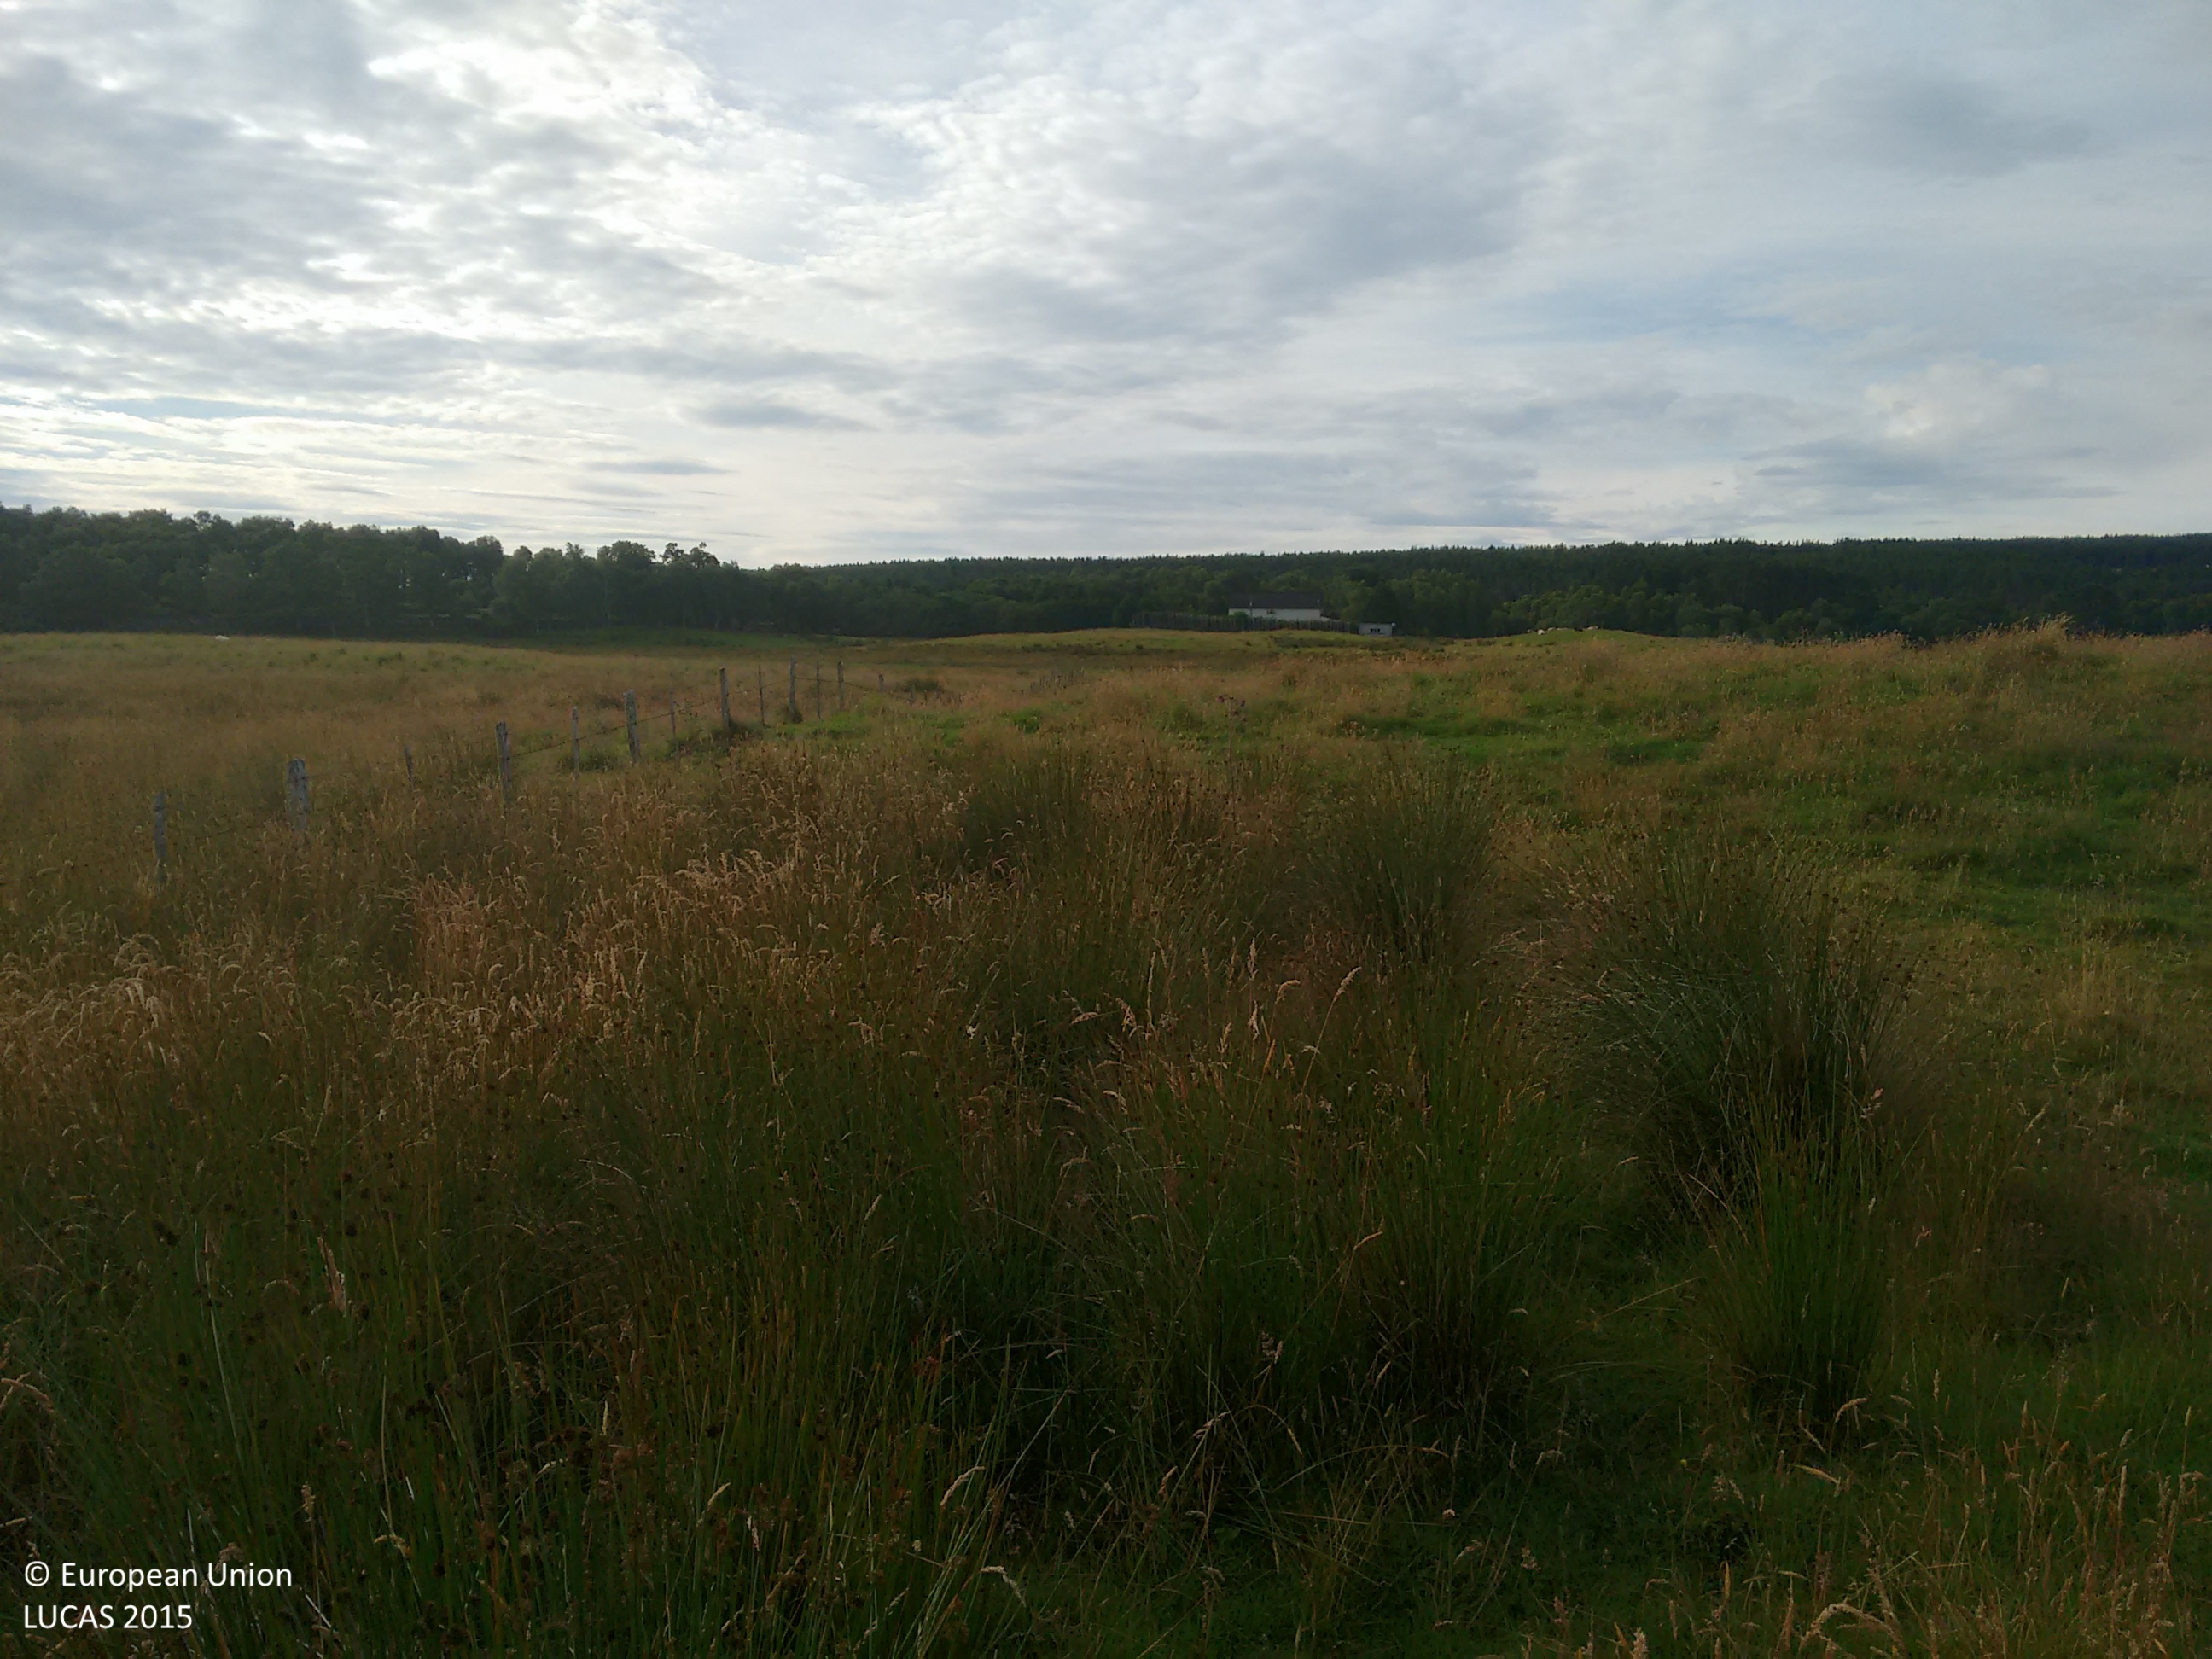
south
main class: Grassland
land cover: Grassland without tree/shrub cover
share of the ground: > 75 %
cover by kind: herbaceous plants 100 %
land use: Agriculture (excluding fallow land and kitchen gardens)
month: August
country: GB
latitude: 57.9308
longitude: -4.0786
